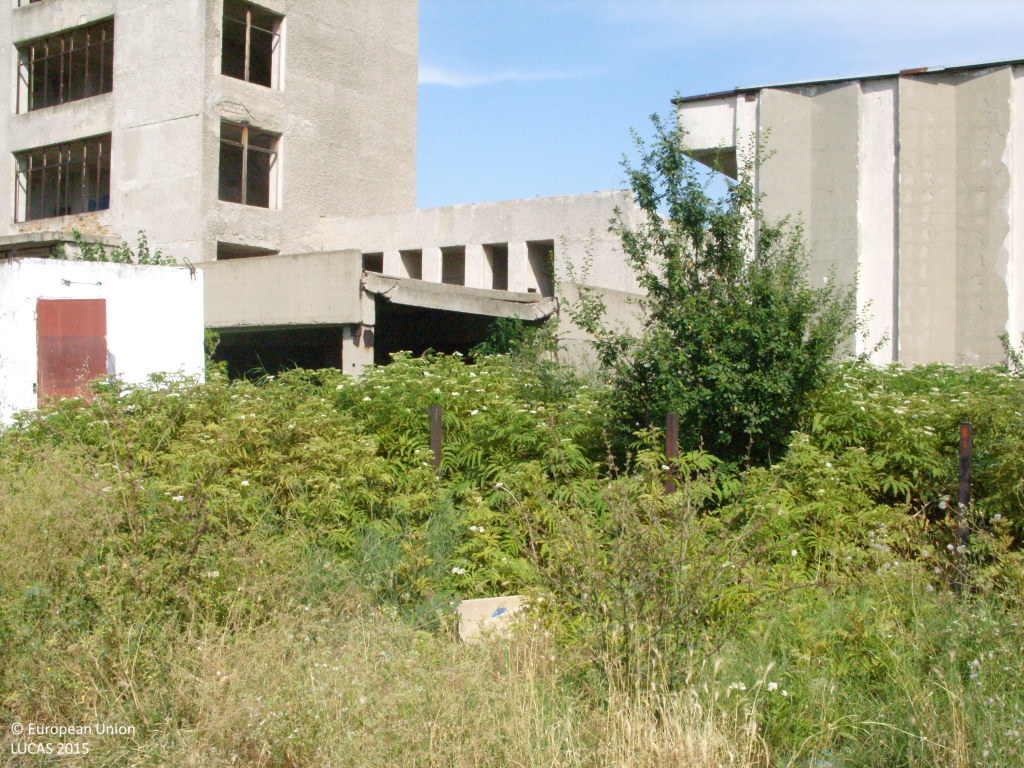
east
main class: Grassland
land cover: Grassland with sparse tree/shrub cover
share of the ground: > 75 %
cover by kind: herbaceous plants 90 %, broadleaved forest trees 5 %, shrubs 5 %
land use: Abandoned areas
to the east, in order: Grassland with sparse tree/shrub cover; Artificial constructions in urban areas
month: July
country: BG
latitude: 42.2073
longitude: 24.1280
